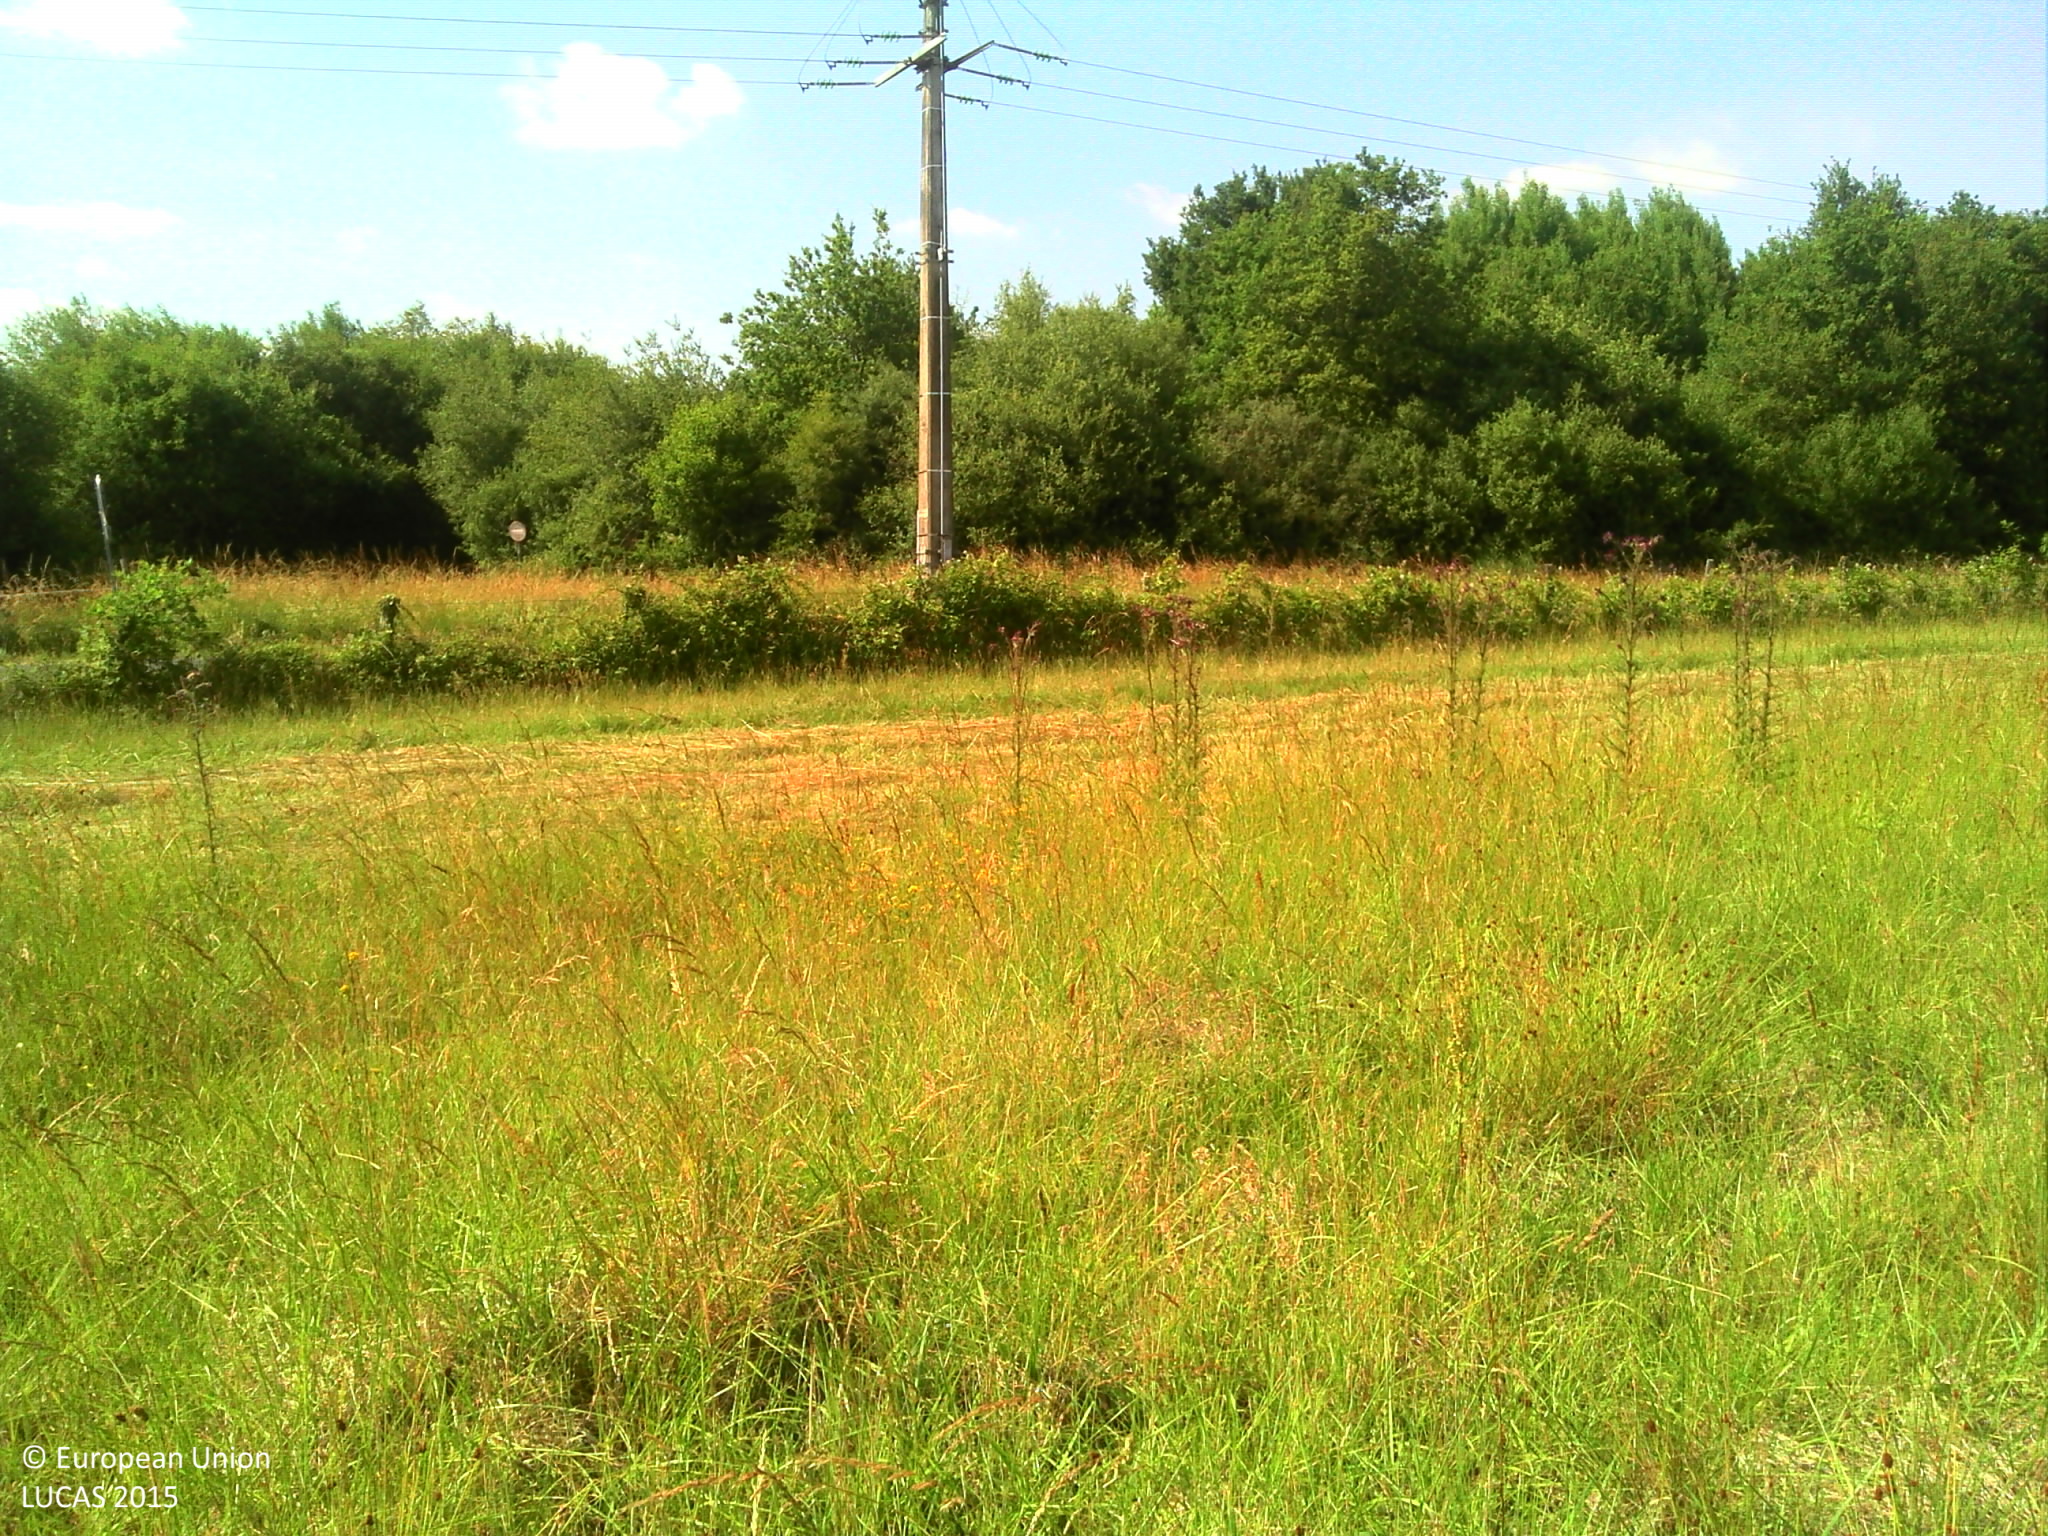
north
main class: Grassland
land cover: Grassland without tree/shrub cover
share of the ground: > 75 %
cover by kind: herbaceous plants 100 %
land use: Agriculture (excluding fallow land and kitchen gardens)
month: June
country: FR
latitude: 47.6105
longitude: 2.0473
